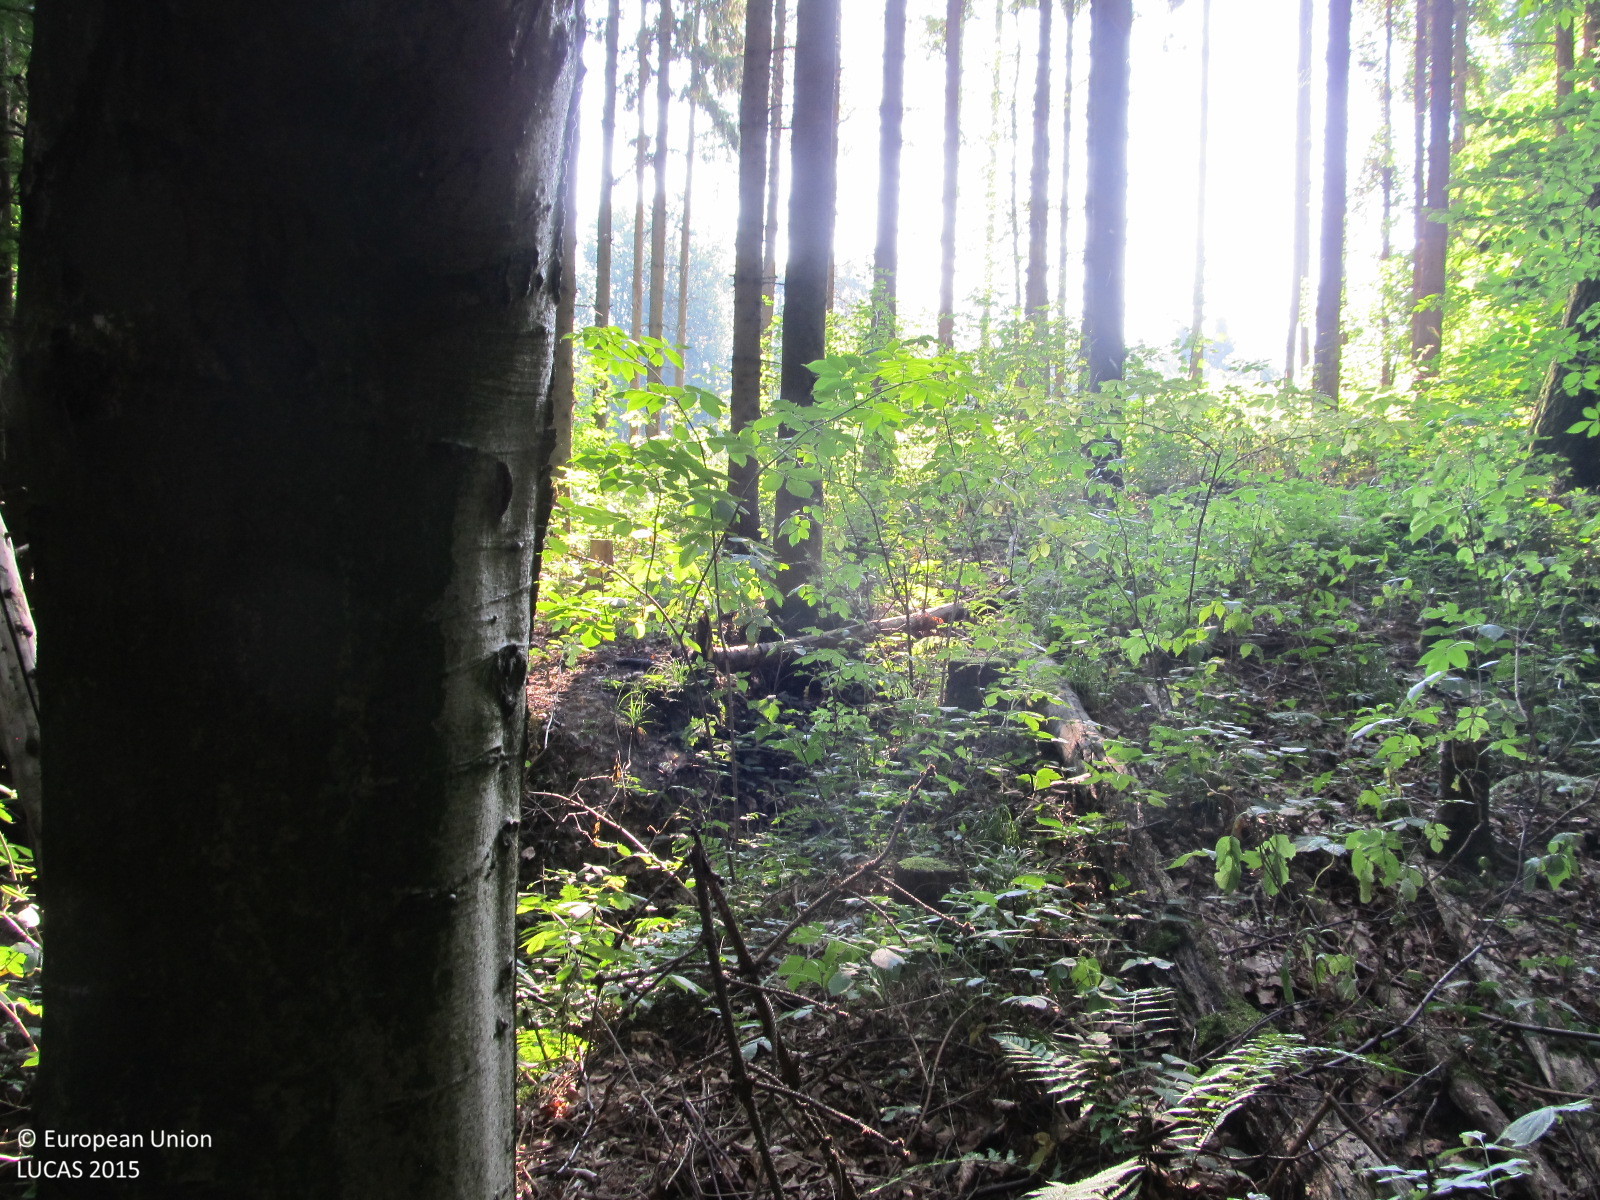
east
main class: Woodland
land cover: Spruce dominated mixed woodland
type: hemiboreal forest and nemoral coniferous forest and mixed broadleaved-coniferous forest
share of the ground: > 75 %
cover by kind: coniferous forest trees 75 %, broadleaved forest trees 25 %
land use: Forestry
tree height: > 5 m
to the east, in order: Spruce dominated mixed woodland; Rivers and streams; Spruce dominated coniferous woodland; Fences; Shrubland with sparse tree cover; Fences; Broadleaved woodland; Spruce dominated coniferous woodland; Spruce dominated mixed woodland; Paved roads, cycling and walking lanes; Grass margins; Broadleaved woodland
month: August
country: AT
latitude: 48.3046
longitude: 15.4626
